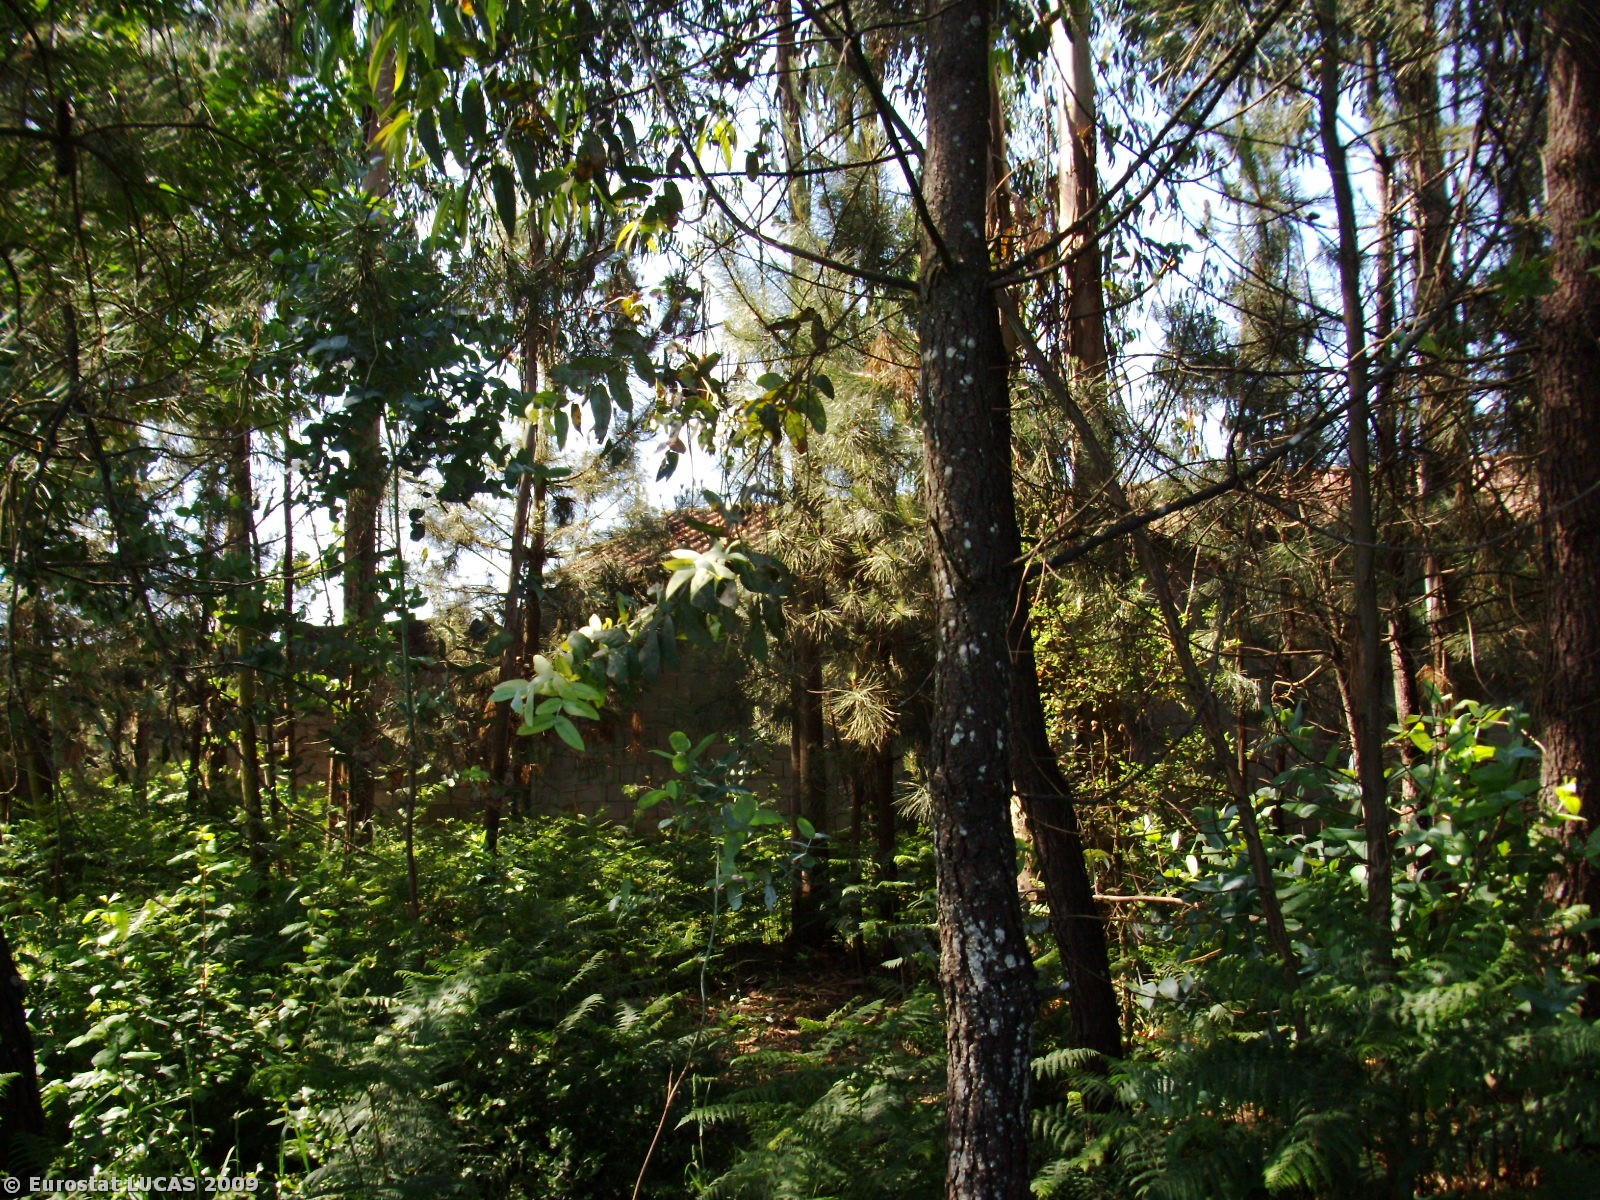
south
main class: Woodland
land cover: Mixed woodland
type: coniferous forest of the mediterranean region
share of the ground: > 75 %
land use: Forestry
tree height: > 5 m
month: May
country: PT
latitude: 41.5971
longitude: -8.5999
